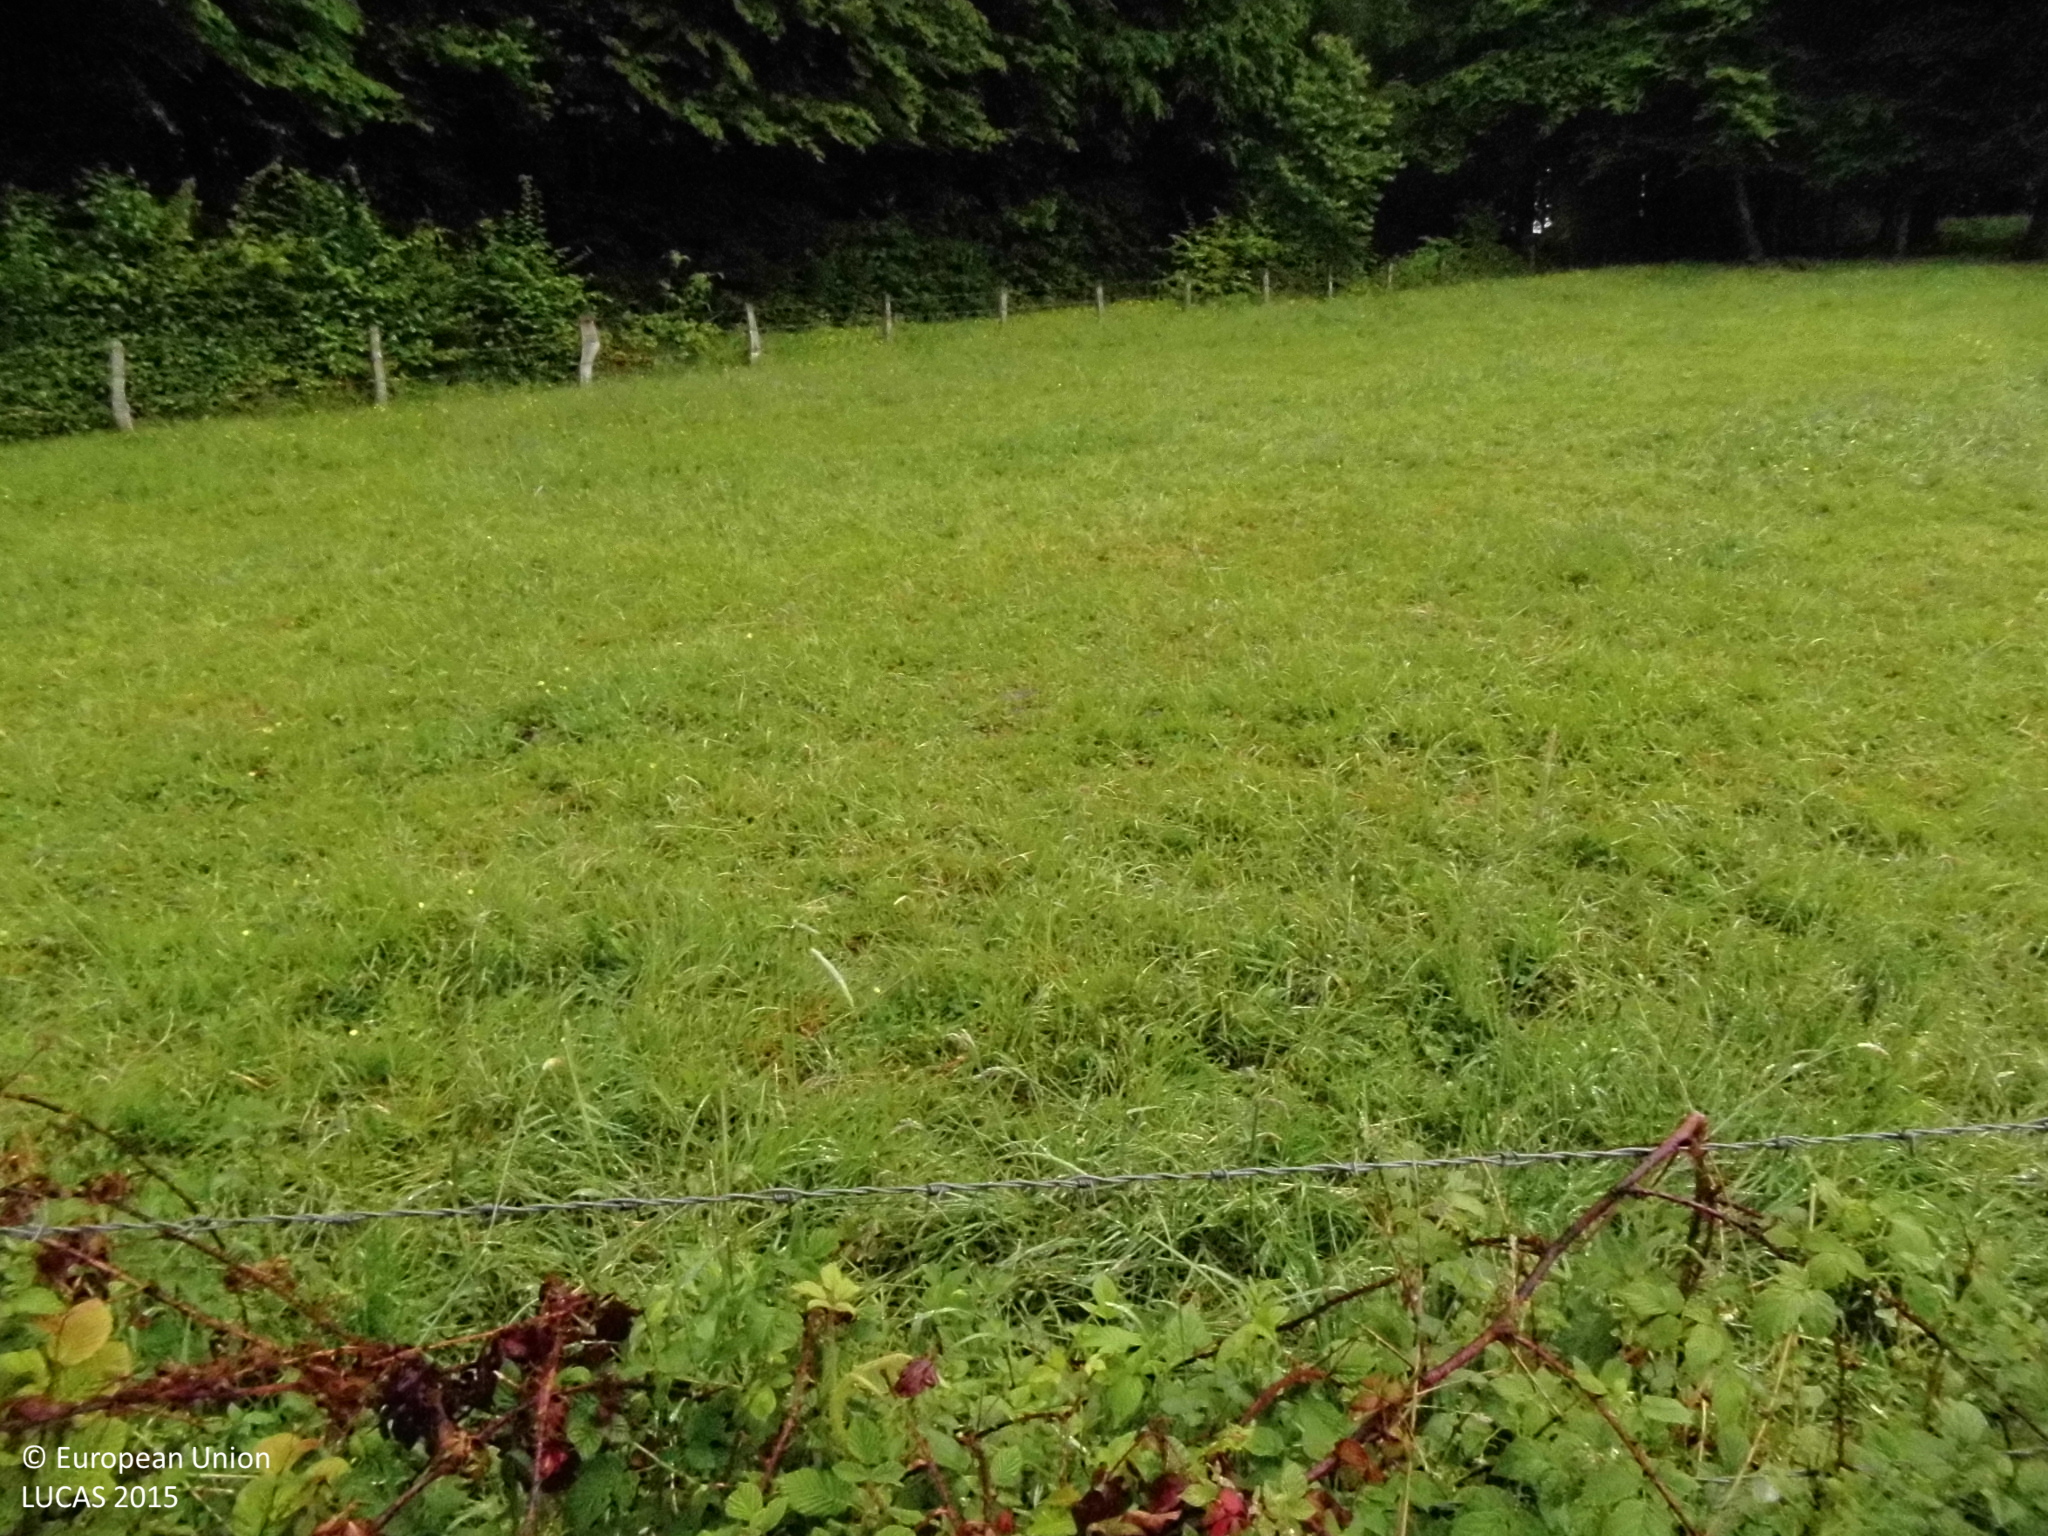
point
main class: Grassland
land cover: Grassland without tree/shrub cover
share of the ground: > 75 %
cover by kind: herbaceous plants 100 %
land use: Agriculture (excluding fallow land and kitchen gardens)
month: May
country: DE
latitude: 50.6605
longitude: 7.4963
